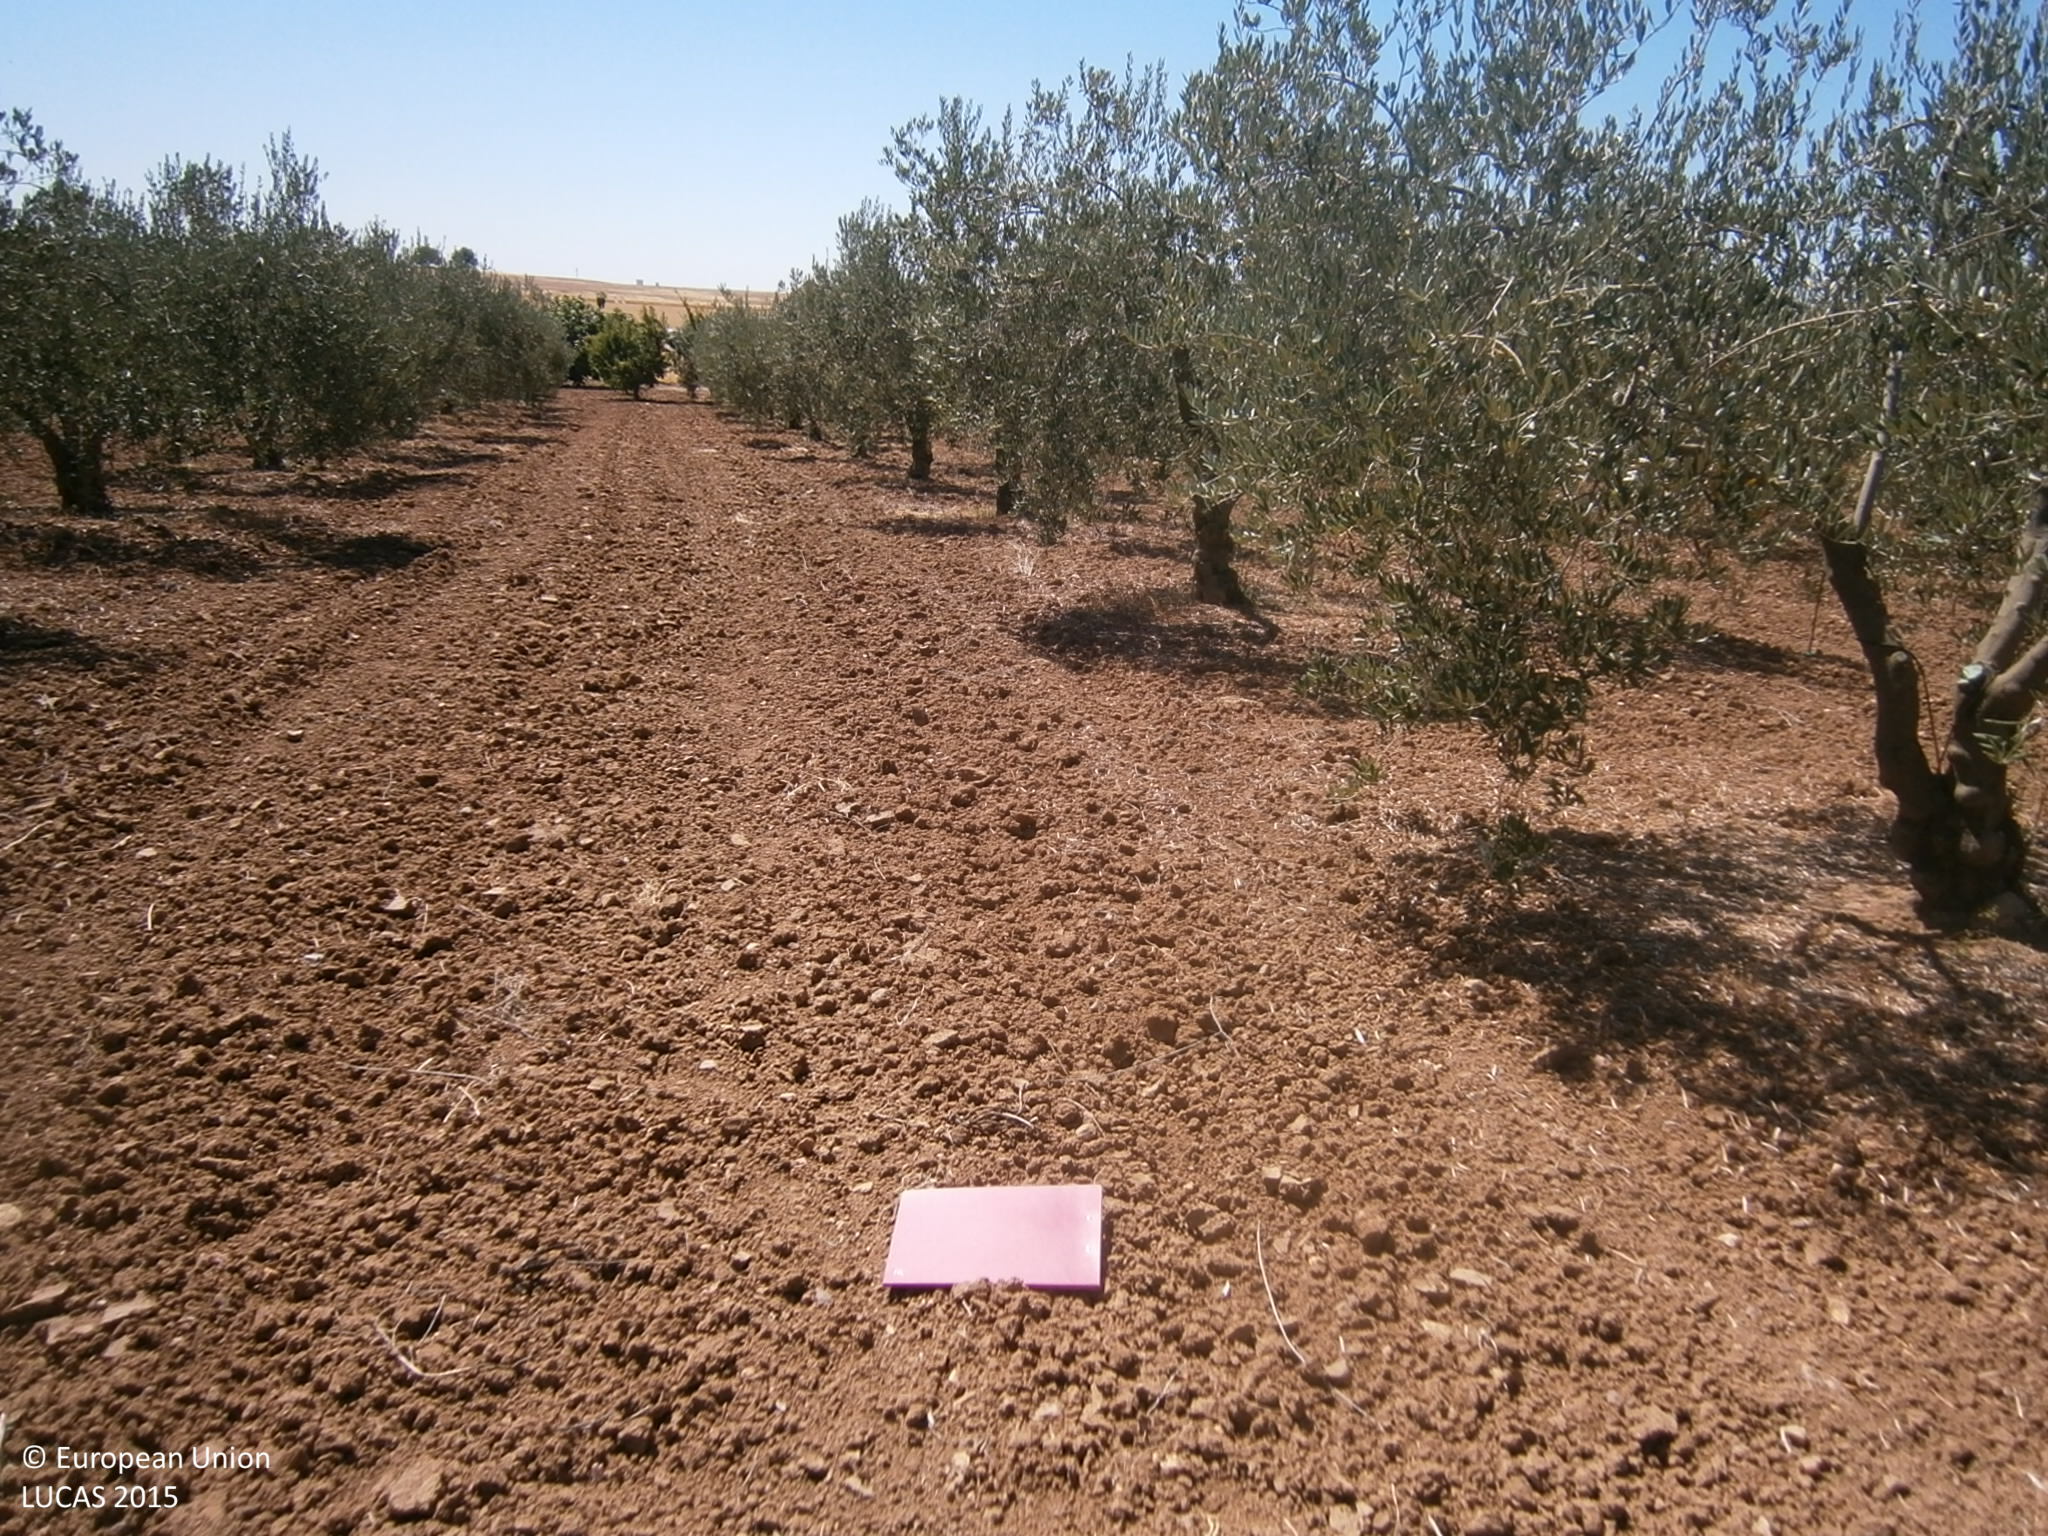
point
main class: Cropland
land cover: Olive groves
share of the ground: 25 - 50 %
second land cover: Other bare soil
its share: > 75 %
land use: Agriculture (excluding fallow land and kitchen gardens)
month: July
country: ES
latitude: 38.9165
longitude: -7.0137
